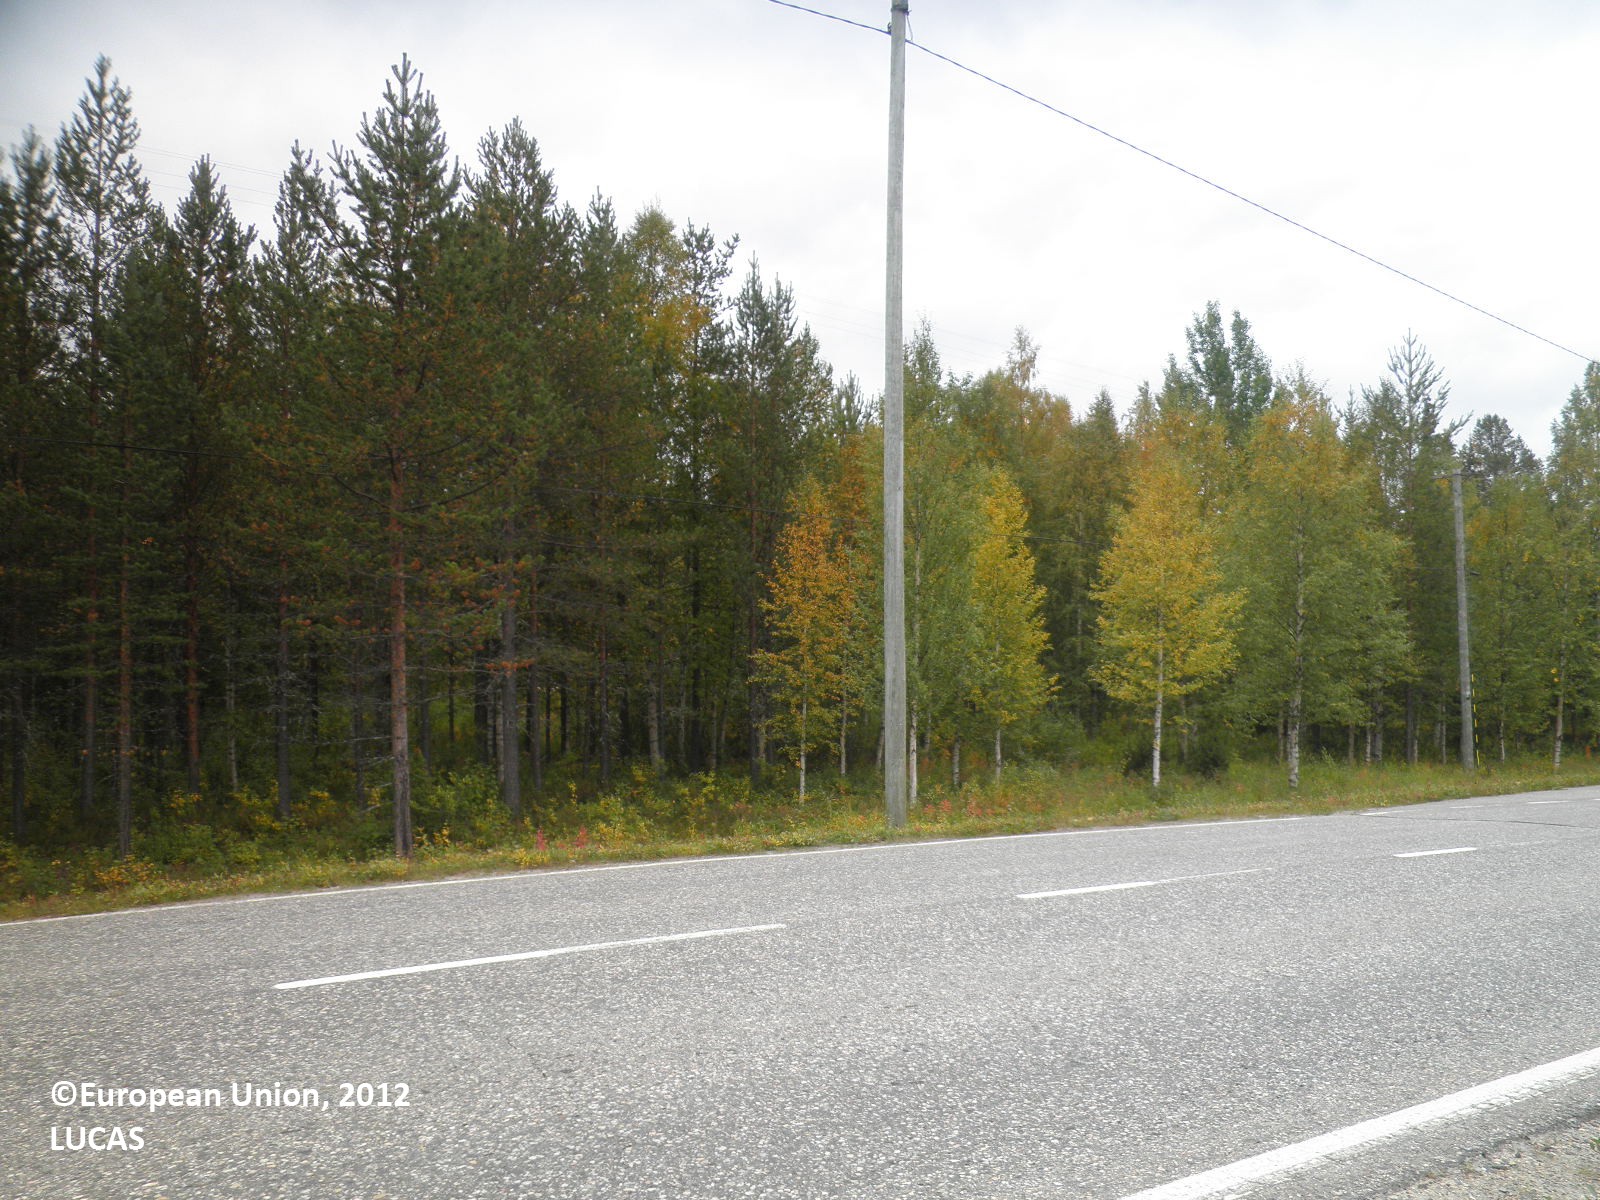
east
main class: Shrubland
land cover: Shrubland with sparse tree cover
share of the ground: > 75 %
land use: Road transport
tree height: < 5 m
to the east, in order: Shrubland with sparse tree cover; Paved roads, cycling and walking lanes; Grass margins; Electric lines; Shrubland with sparse tree cover; Pine dominated mixed woodland; Tracks; Pine dominated mixed woodland; Grassland without tree/shrub cover; Artificial constructions in urban areas
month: August
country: FI
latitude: 67.2982
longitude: 28.1626
